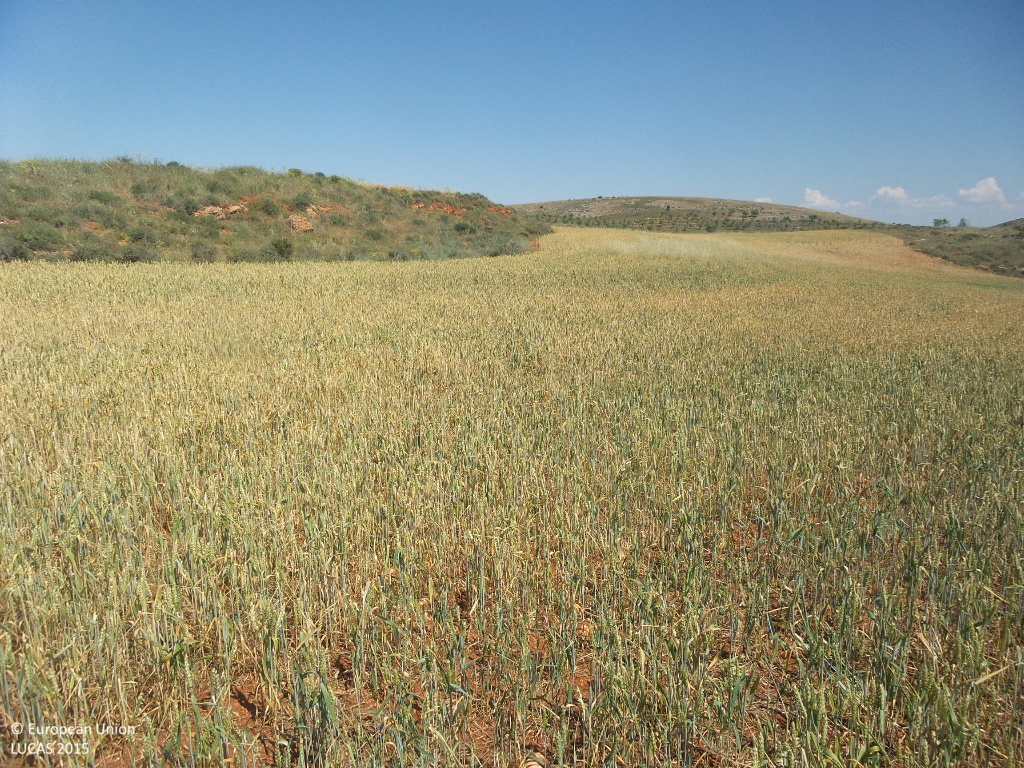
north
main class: Cropland
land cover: Common wheat
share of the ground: > 75 %
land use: Agriculture (excluding fallow land and kitchen gardens)
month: June
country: ES
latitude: 41.4014
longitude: -3.0671
